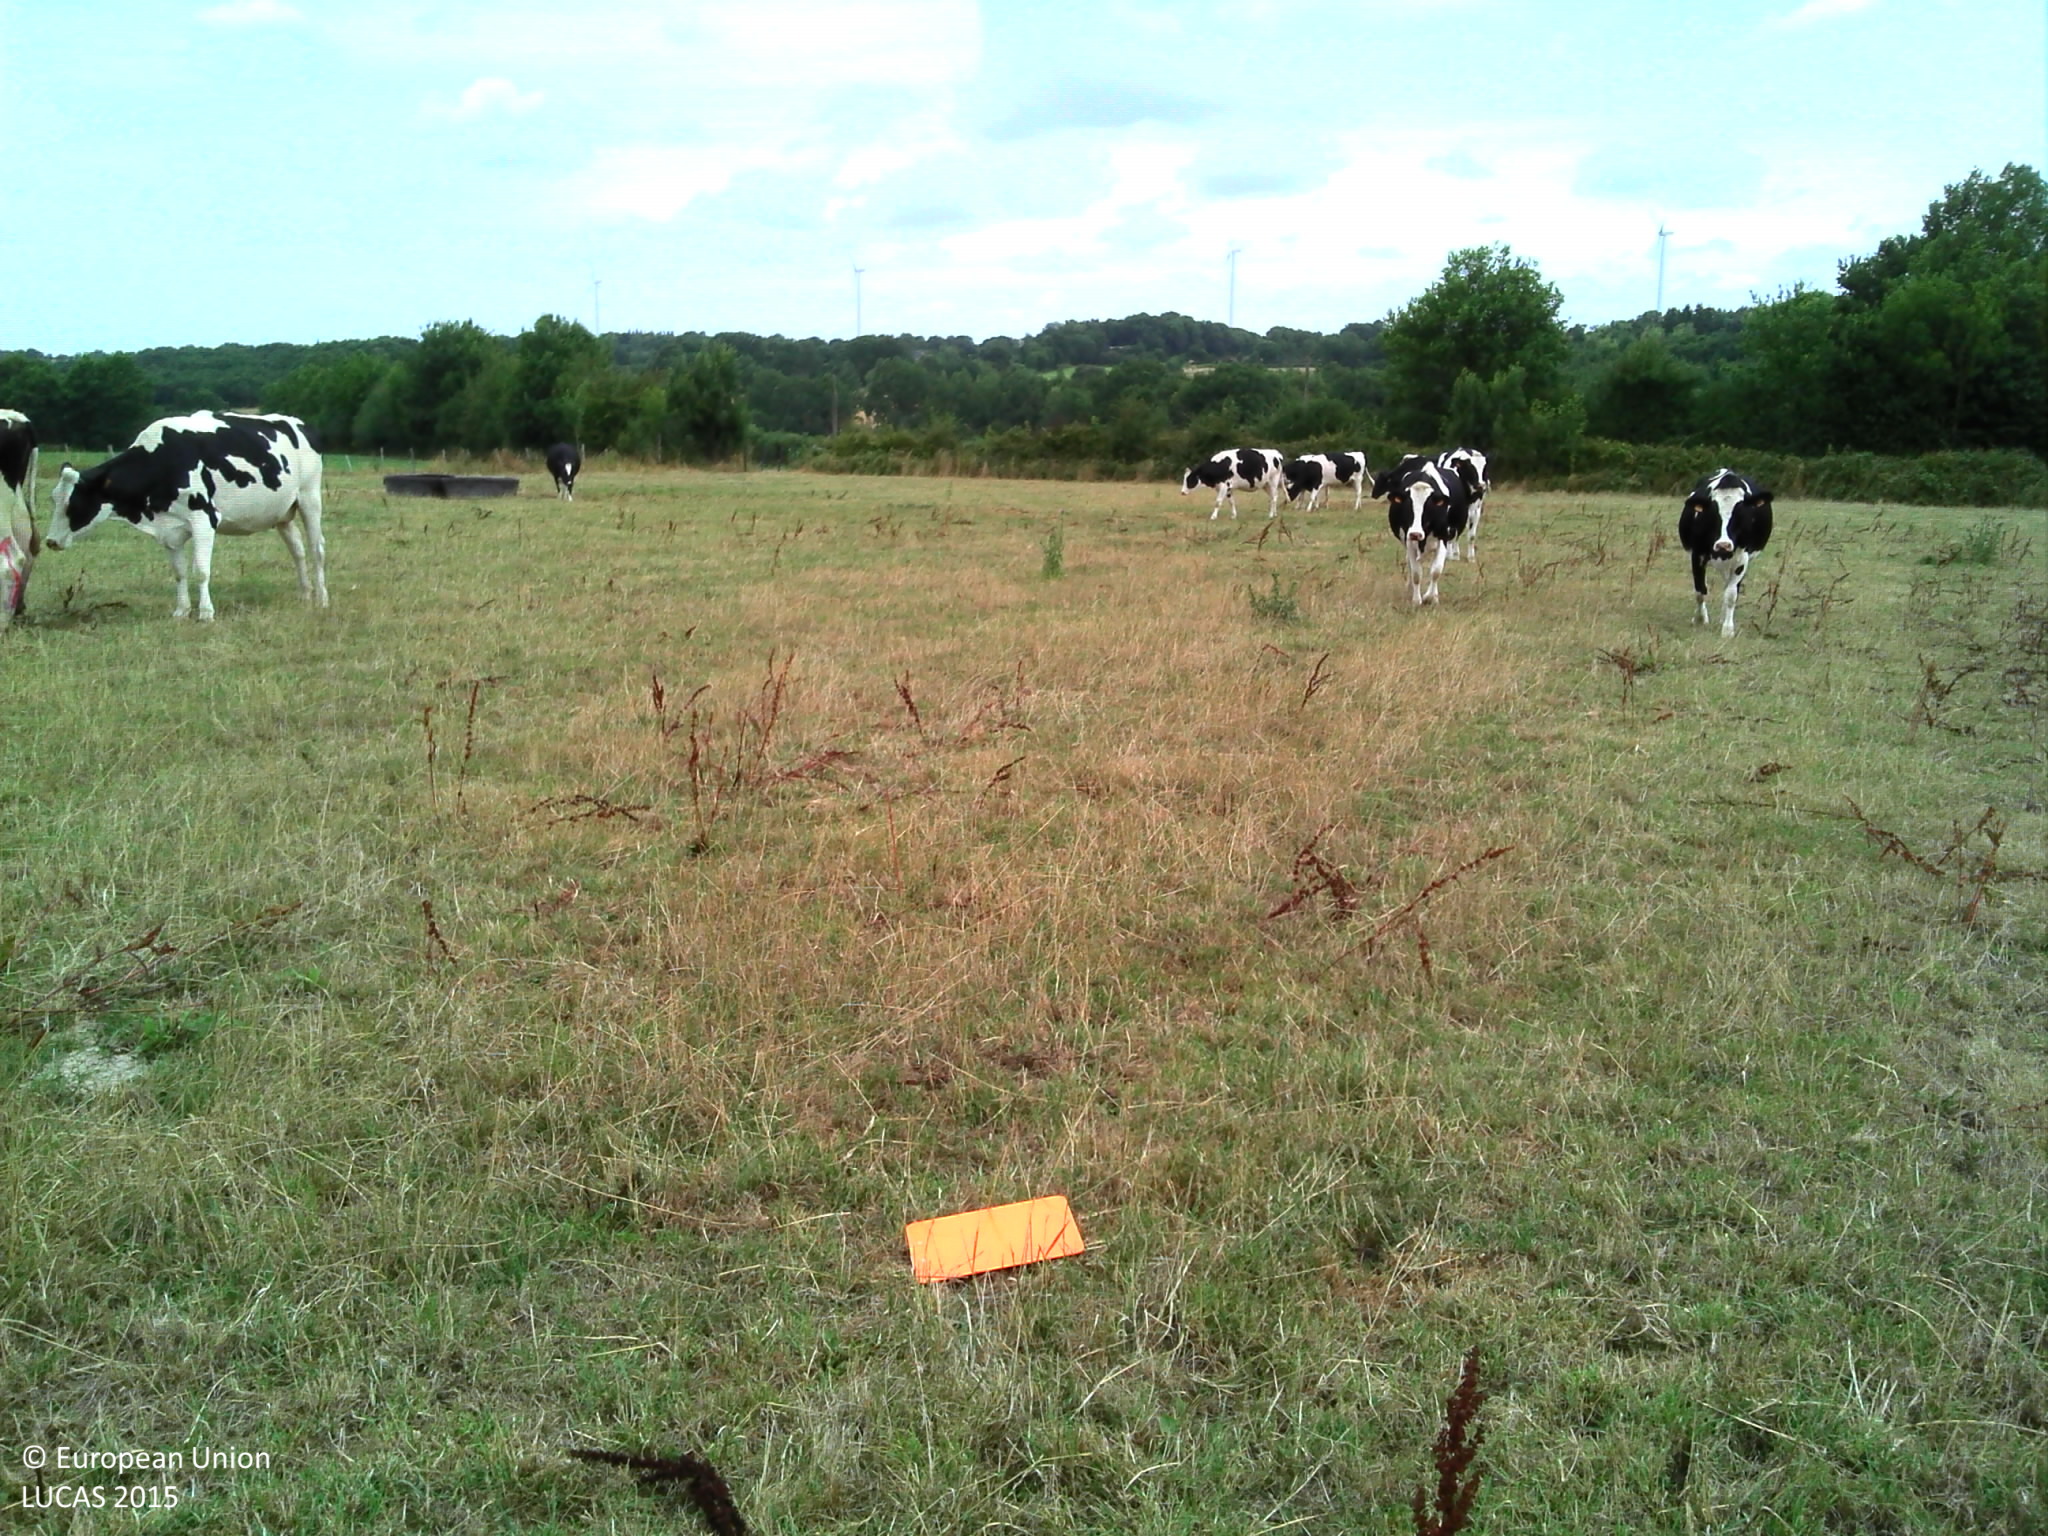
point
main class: Cropland
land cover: Temporary grasslands
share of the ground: > 75 %
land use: Agriculture (excluding fallow land and kitchen gardens)
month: July
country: FR
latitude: 47.7233
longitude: -1.5497
